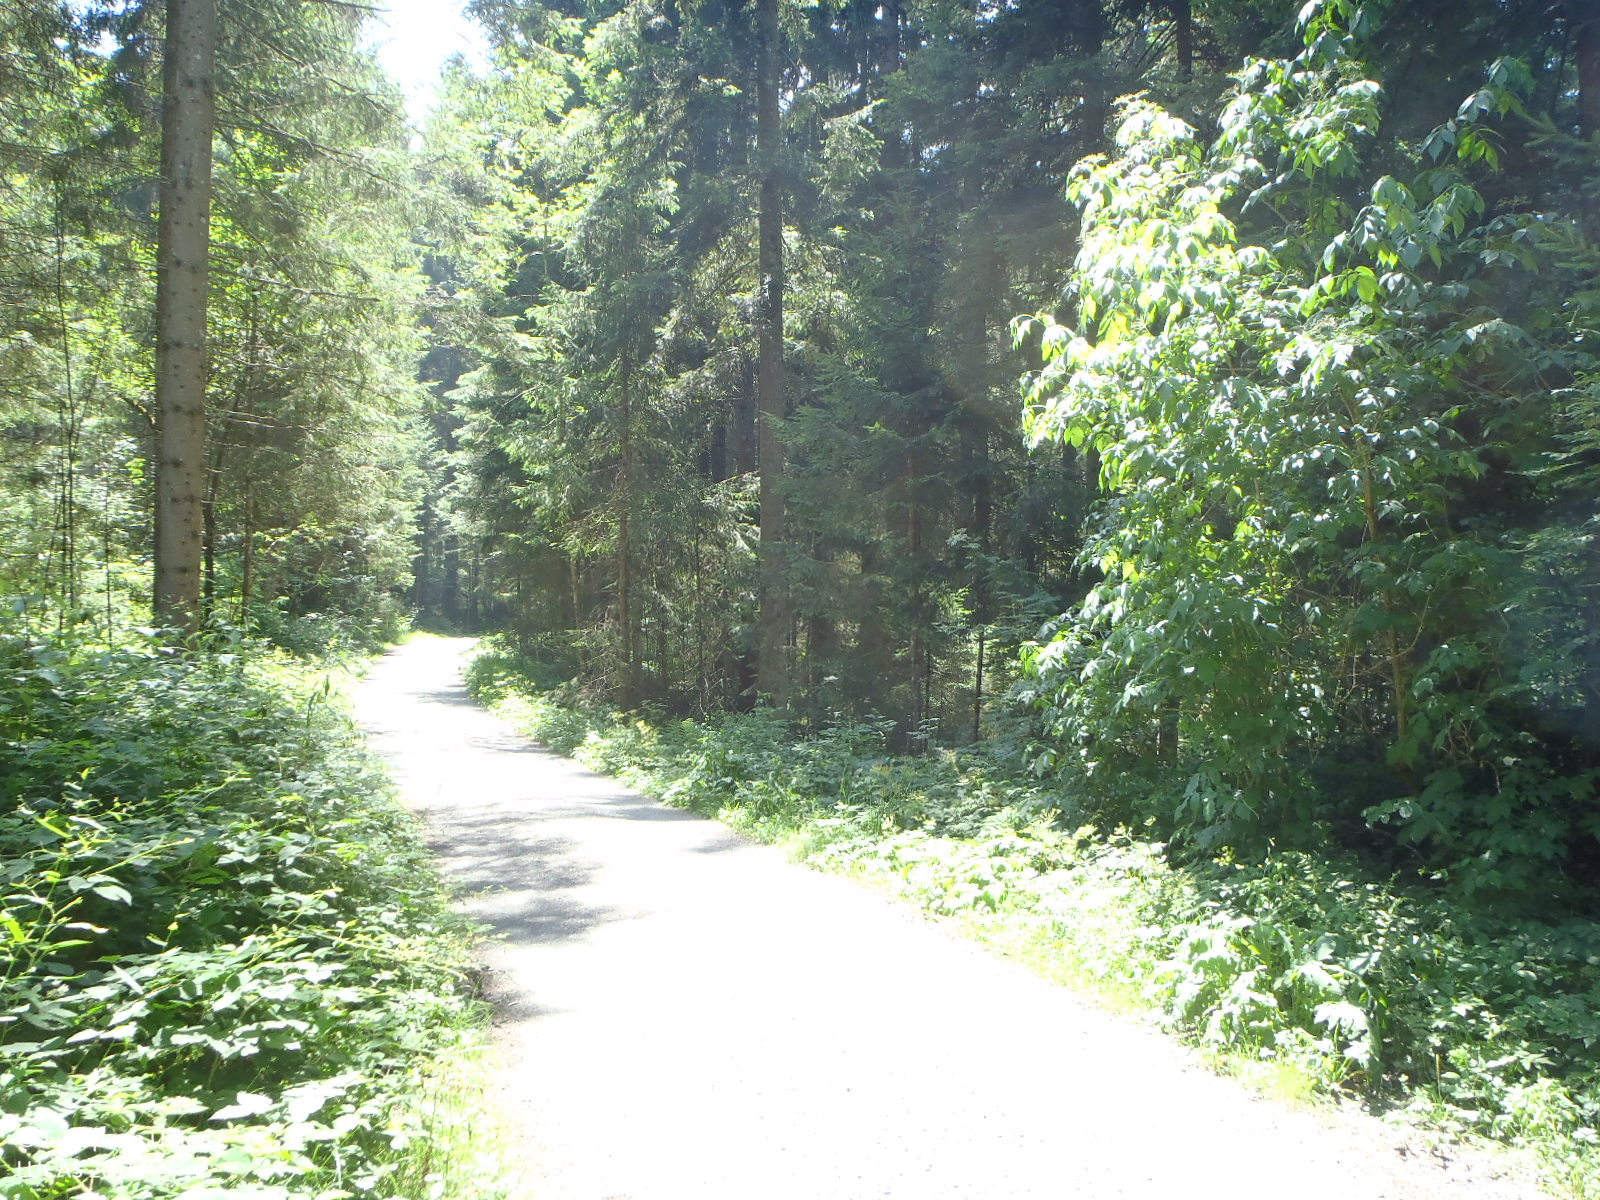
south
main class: Woodland
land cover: Other coniferous woodland
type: alpine coniferous forest
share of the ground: > 75 %
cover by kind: coniferous forest trees 75 %, broadleaved forest trees 25 %
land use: Forestry
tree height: > 5 m
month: July
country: AT
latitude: 47.4778
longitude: 12.3736
